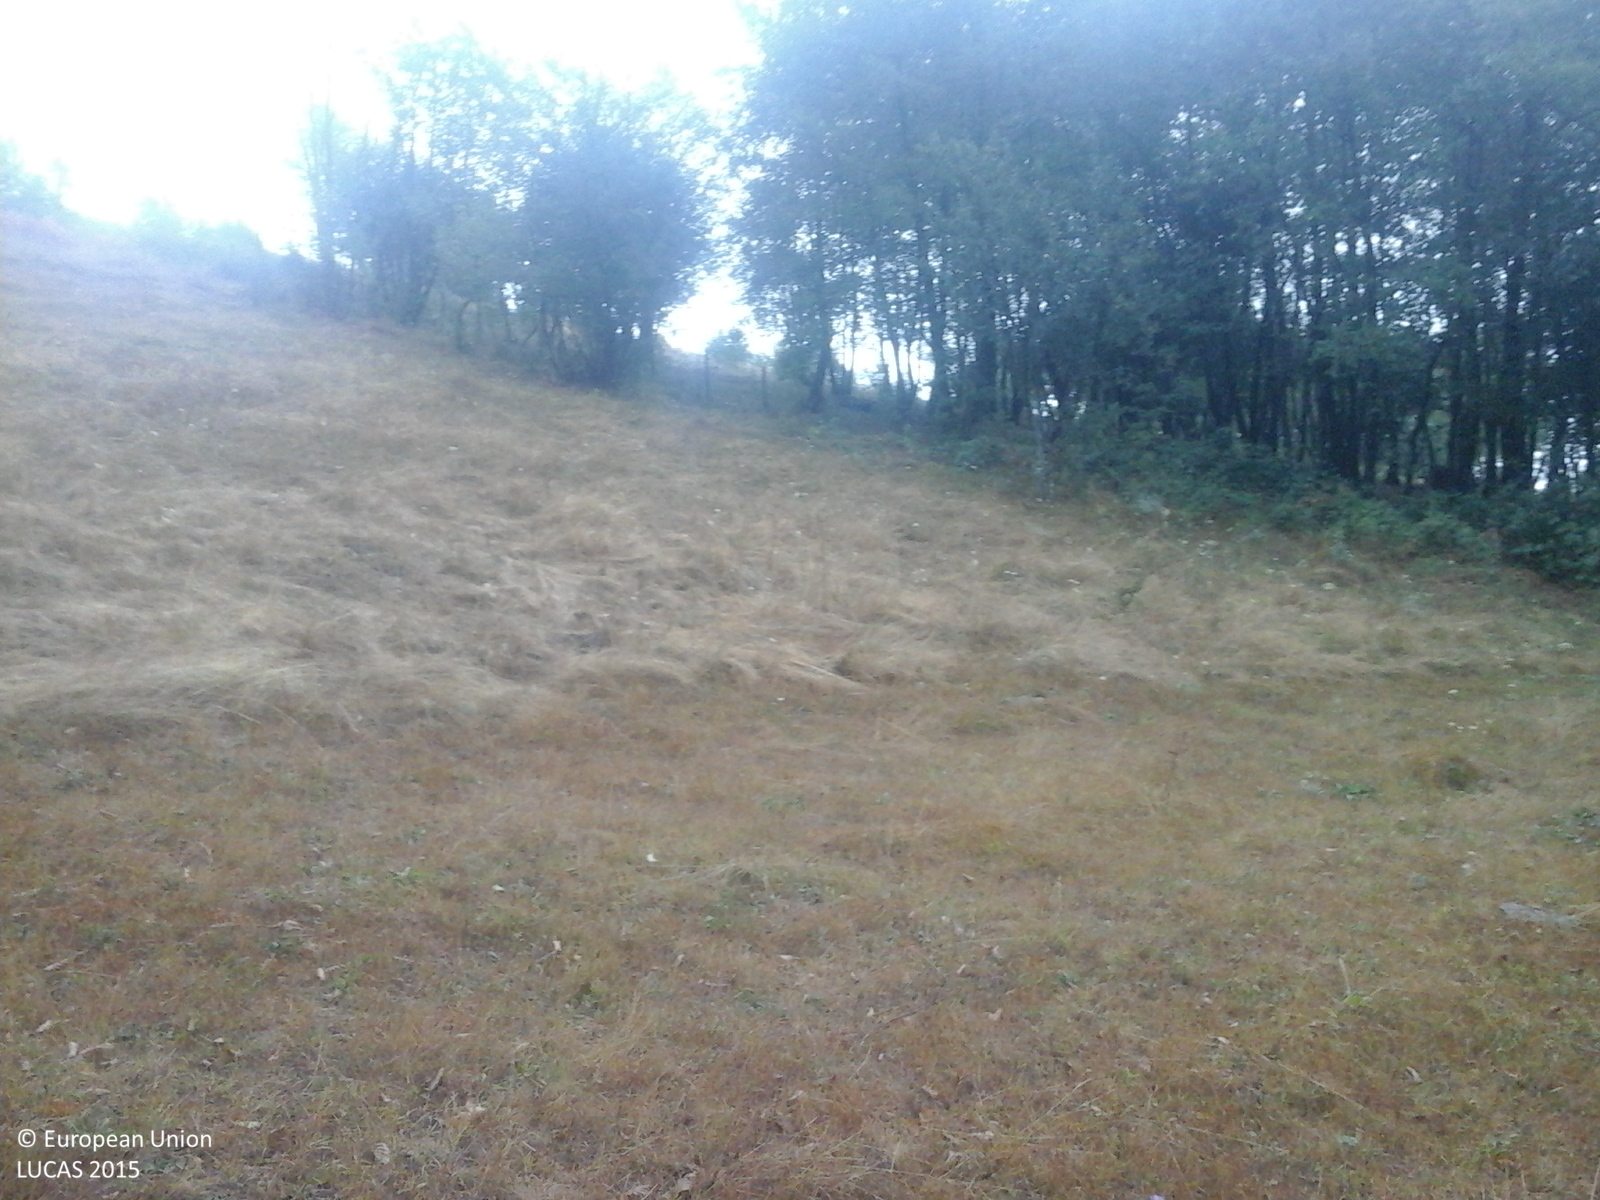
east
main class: Grassland
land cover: Grassland without tree/shrub cover
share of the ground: > 75 %
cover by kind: herbaceous plants 100 %
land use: Agriculture (excluding fallow land and kitchen gardens)
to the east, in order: Grassland without tree/shrub cover; Groves; Fences; Broadleaved woodland; Grassland with sparse tree/shrub cover; Grassland without tree/shrub cover; Lines of trees; Grassland without tree/shrub cover
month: August
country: RO
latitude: 44.9756
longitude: 22.6612
